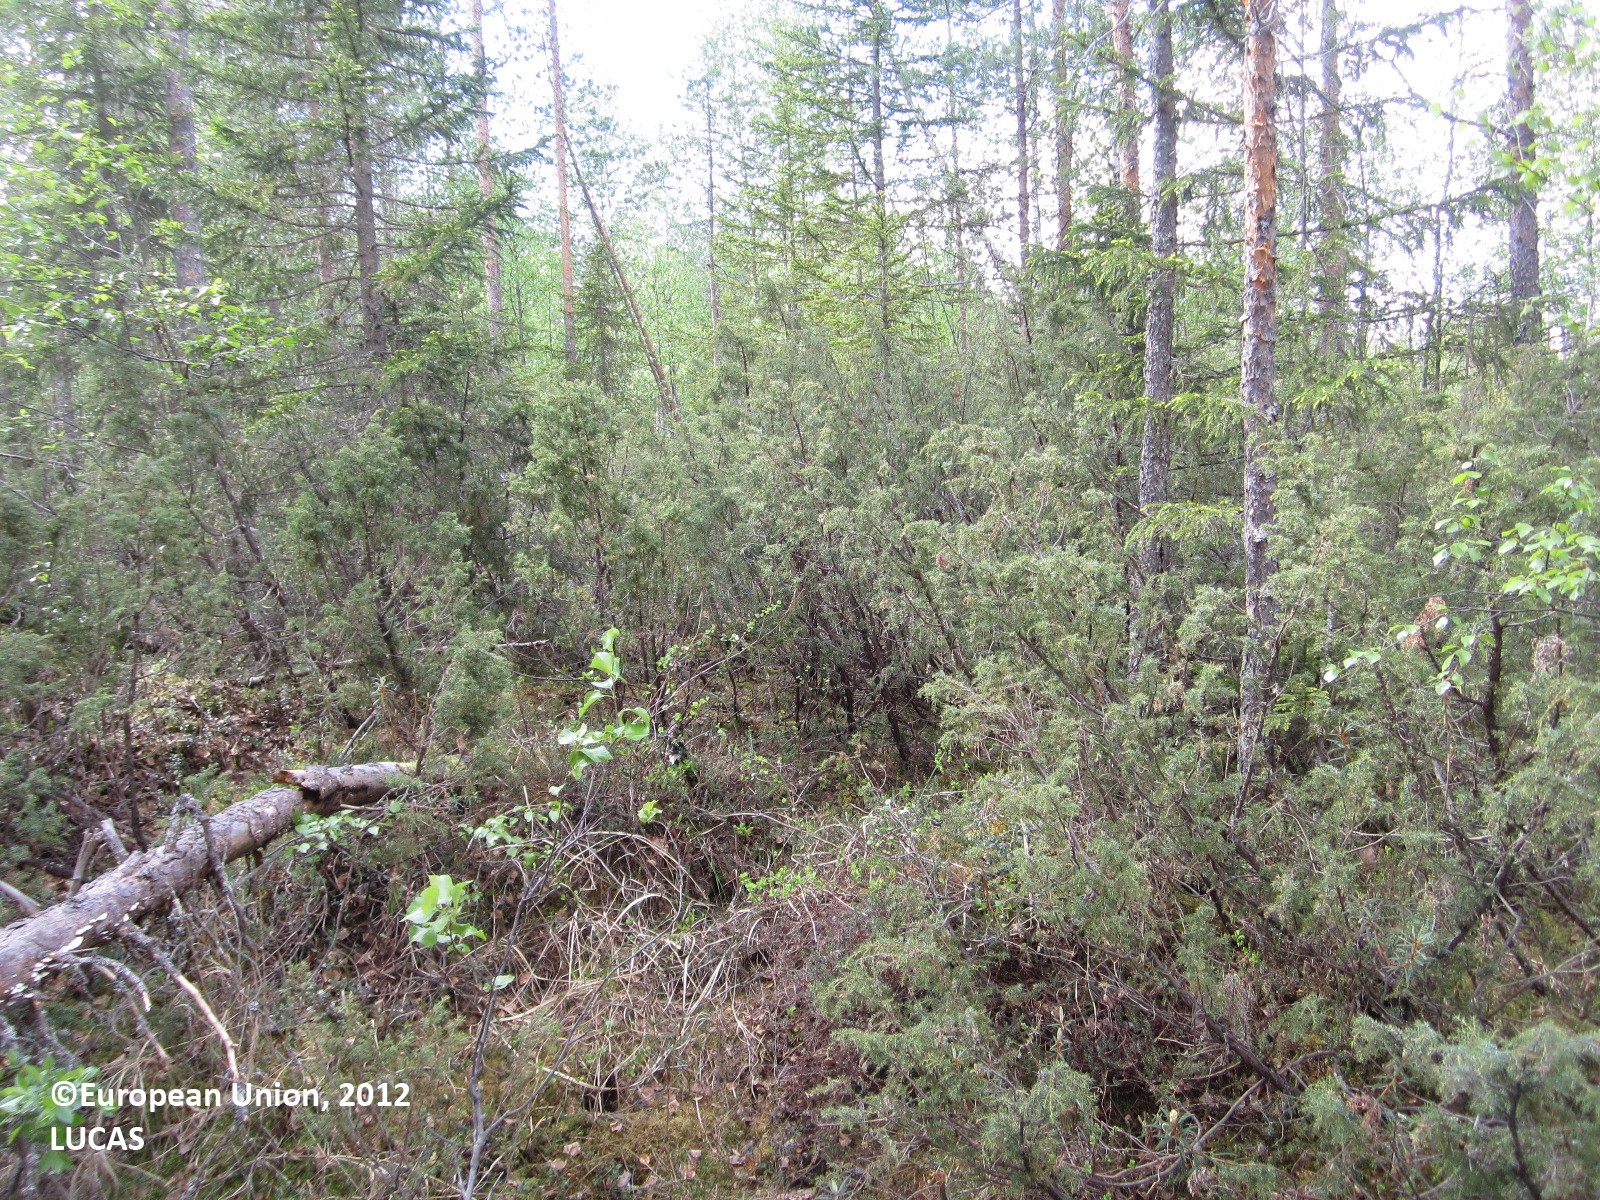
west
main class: Woodland
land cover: Other coniferous woodland
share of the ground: 50 - 75 %
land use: Forestry
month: June
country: FI
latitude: 64.5903
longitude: 28.7527
